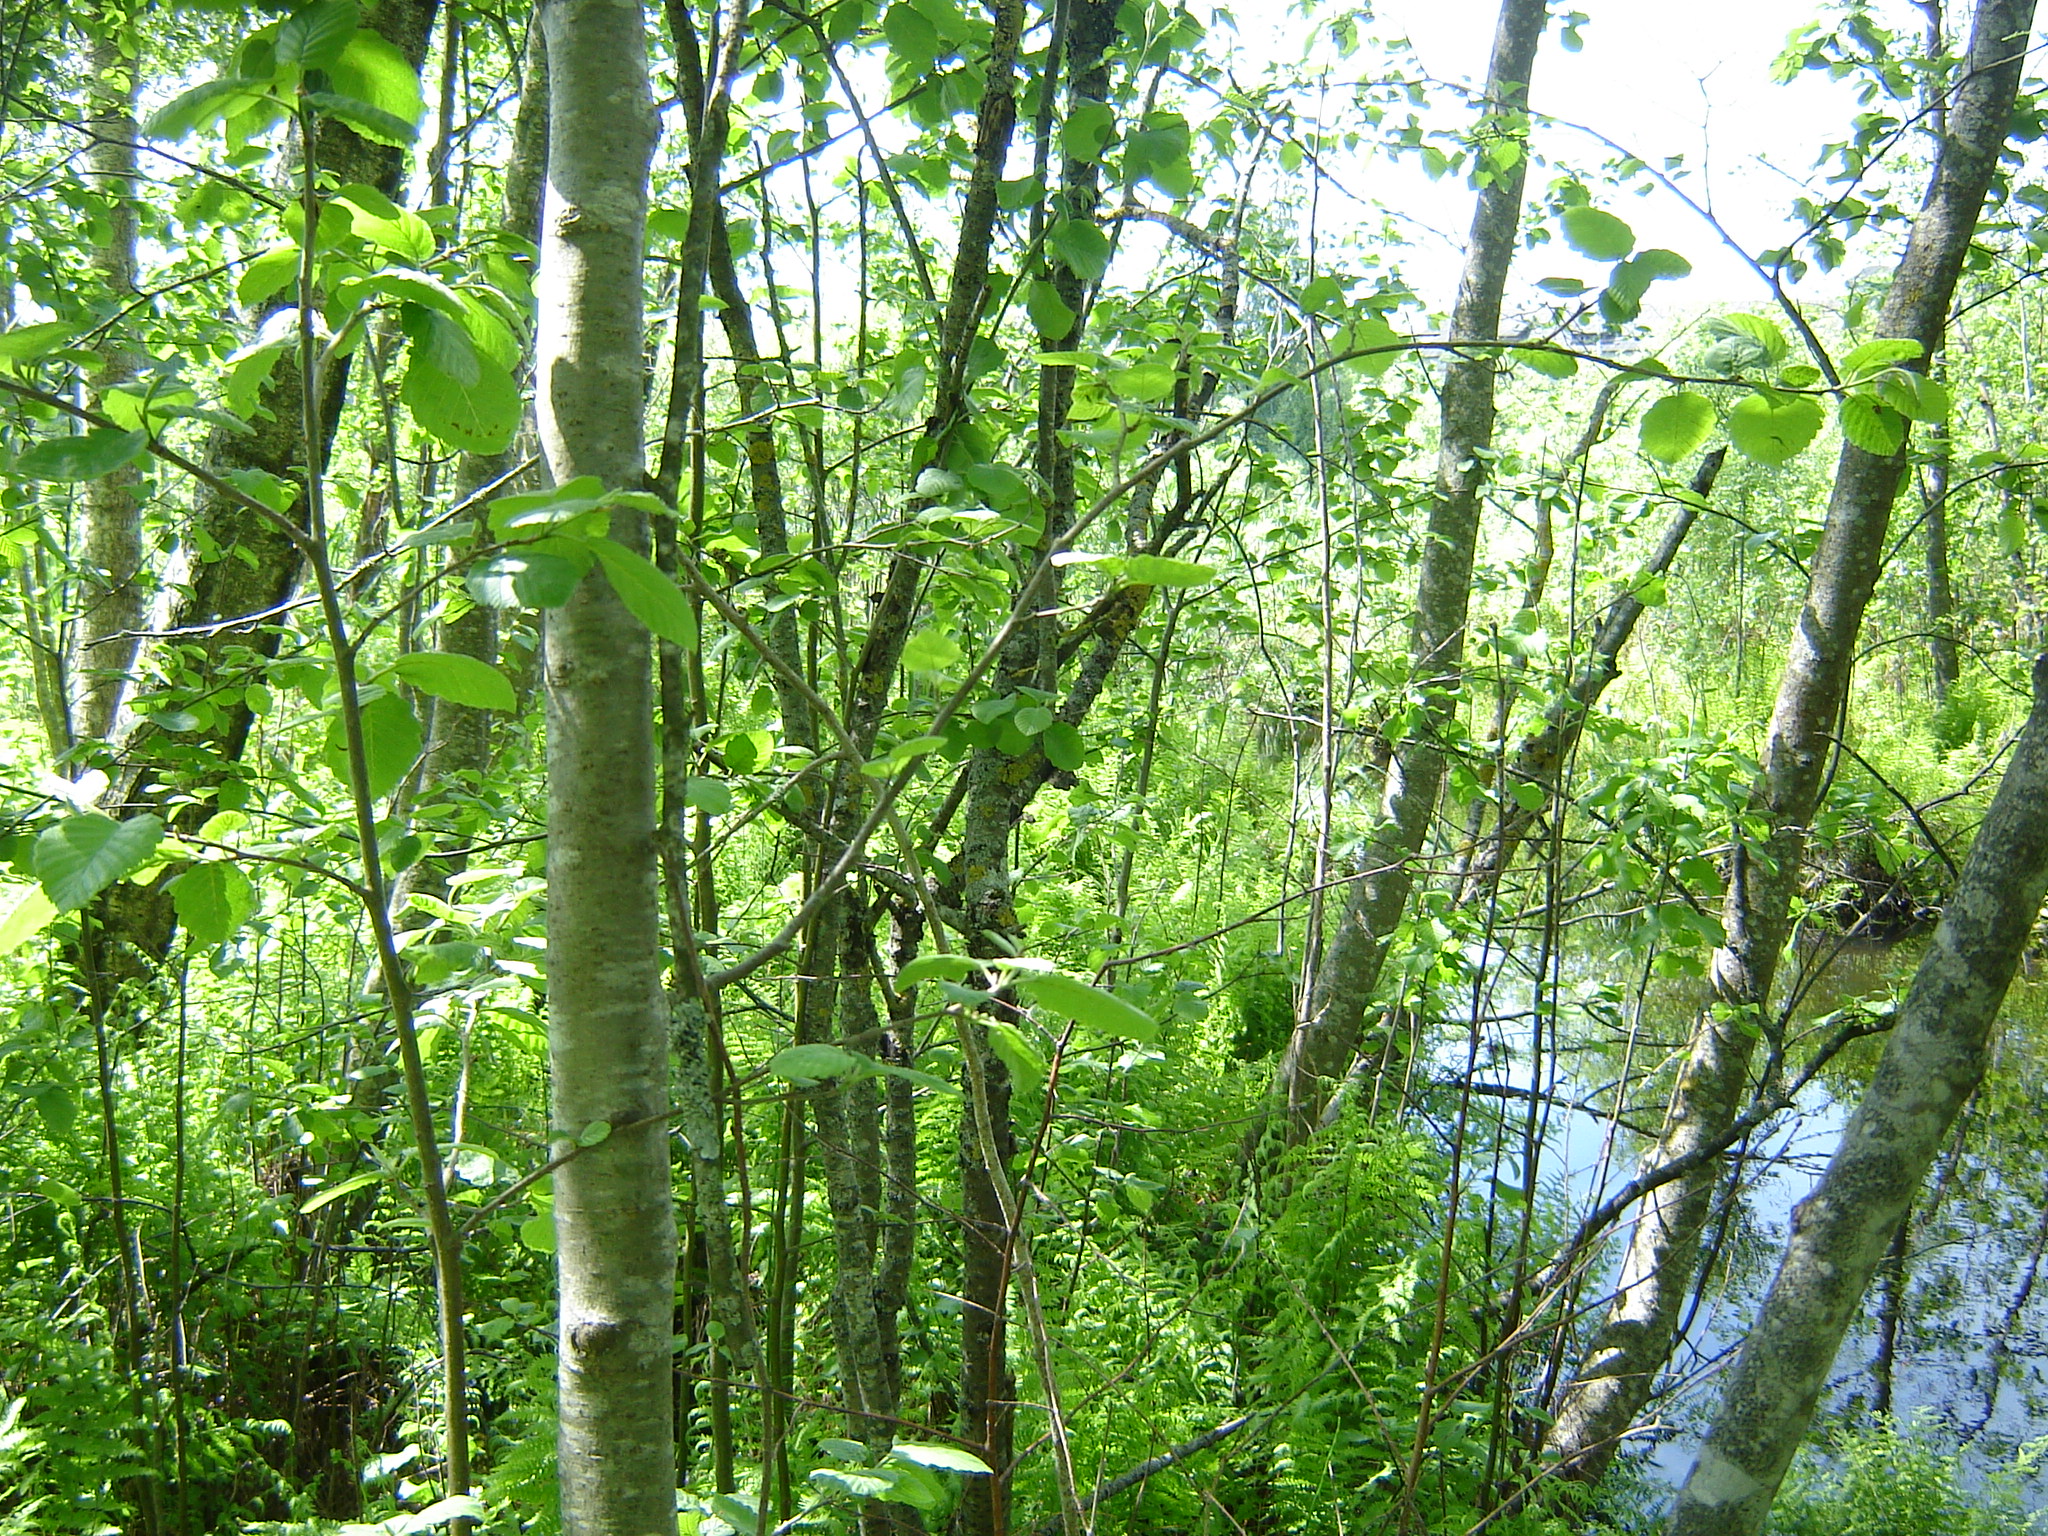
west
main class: Woodland
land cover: Broadleaved woodland
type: floodplain forest
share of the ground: > 75 %
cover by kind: broadleaved forest trees 80 %, herbaceous plants 20 %
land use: Semi-natural and natural areas not in use
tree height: > 5 m
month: June
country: LT
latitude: 55.5475
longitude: 25.5148
